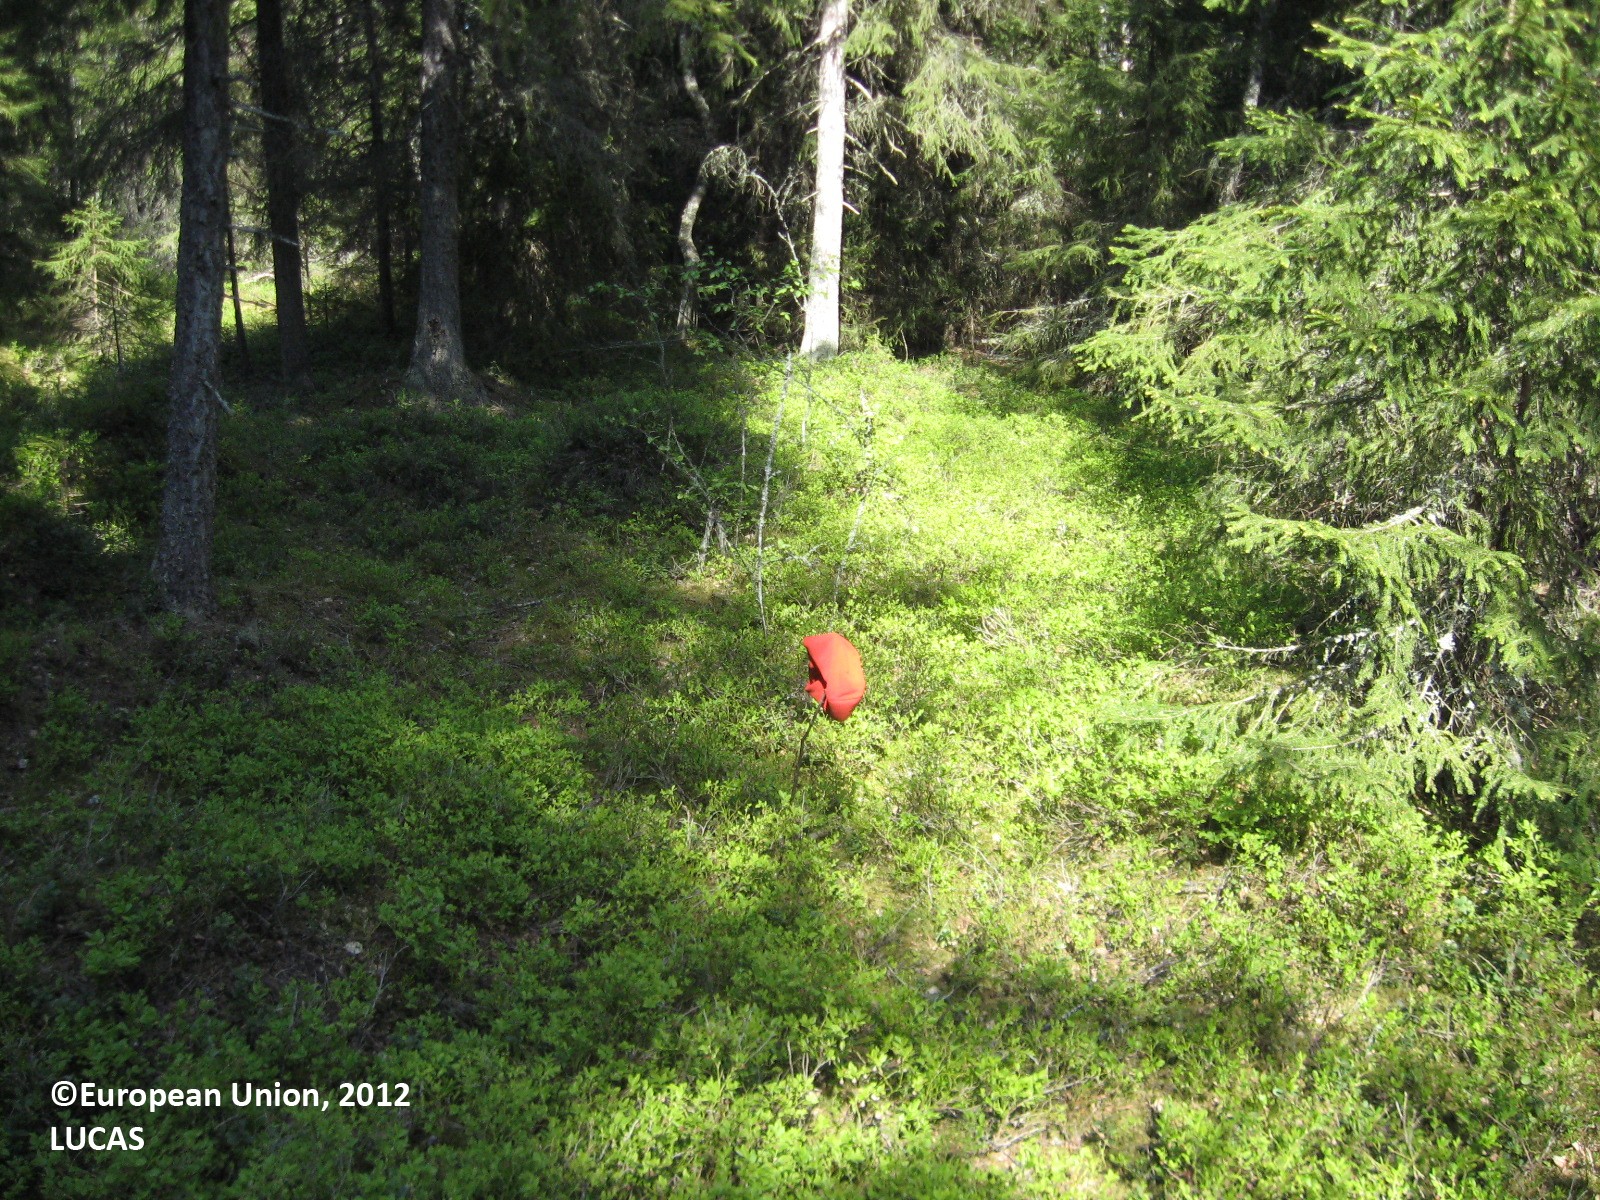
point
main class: Woodland
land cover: Spruce dominated coniferous woodland
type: boreal forest
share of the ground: > 75 %
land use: Forestry
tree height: > 5 m
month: June
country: FI
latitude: 63.2546
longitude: 21.4093
